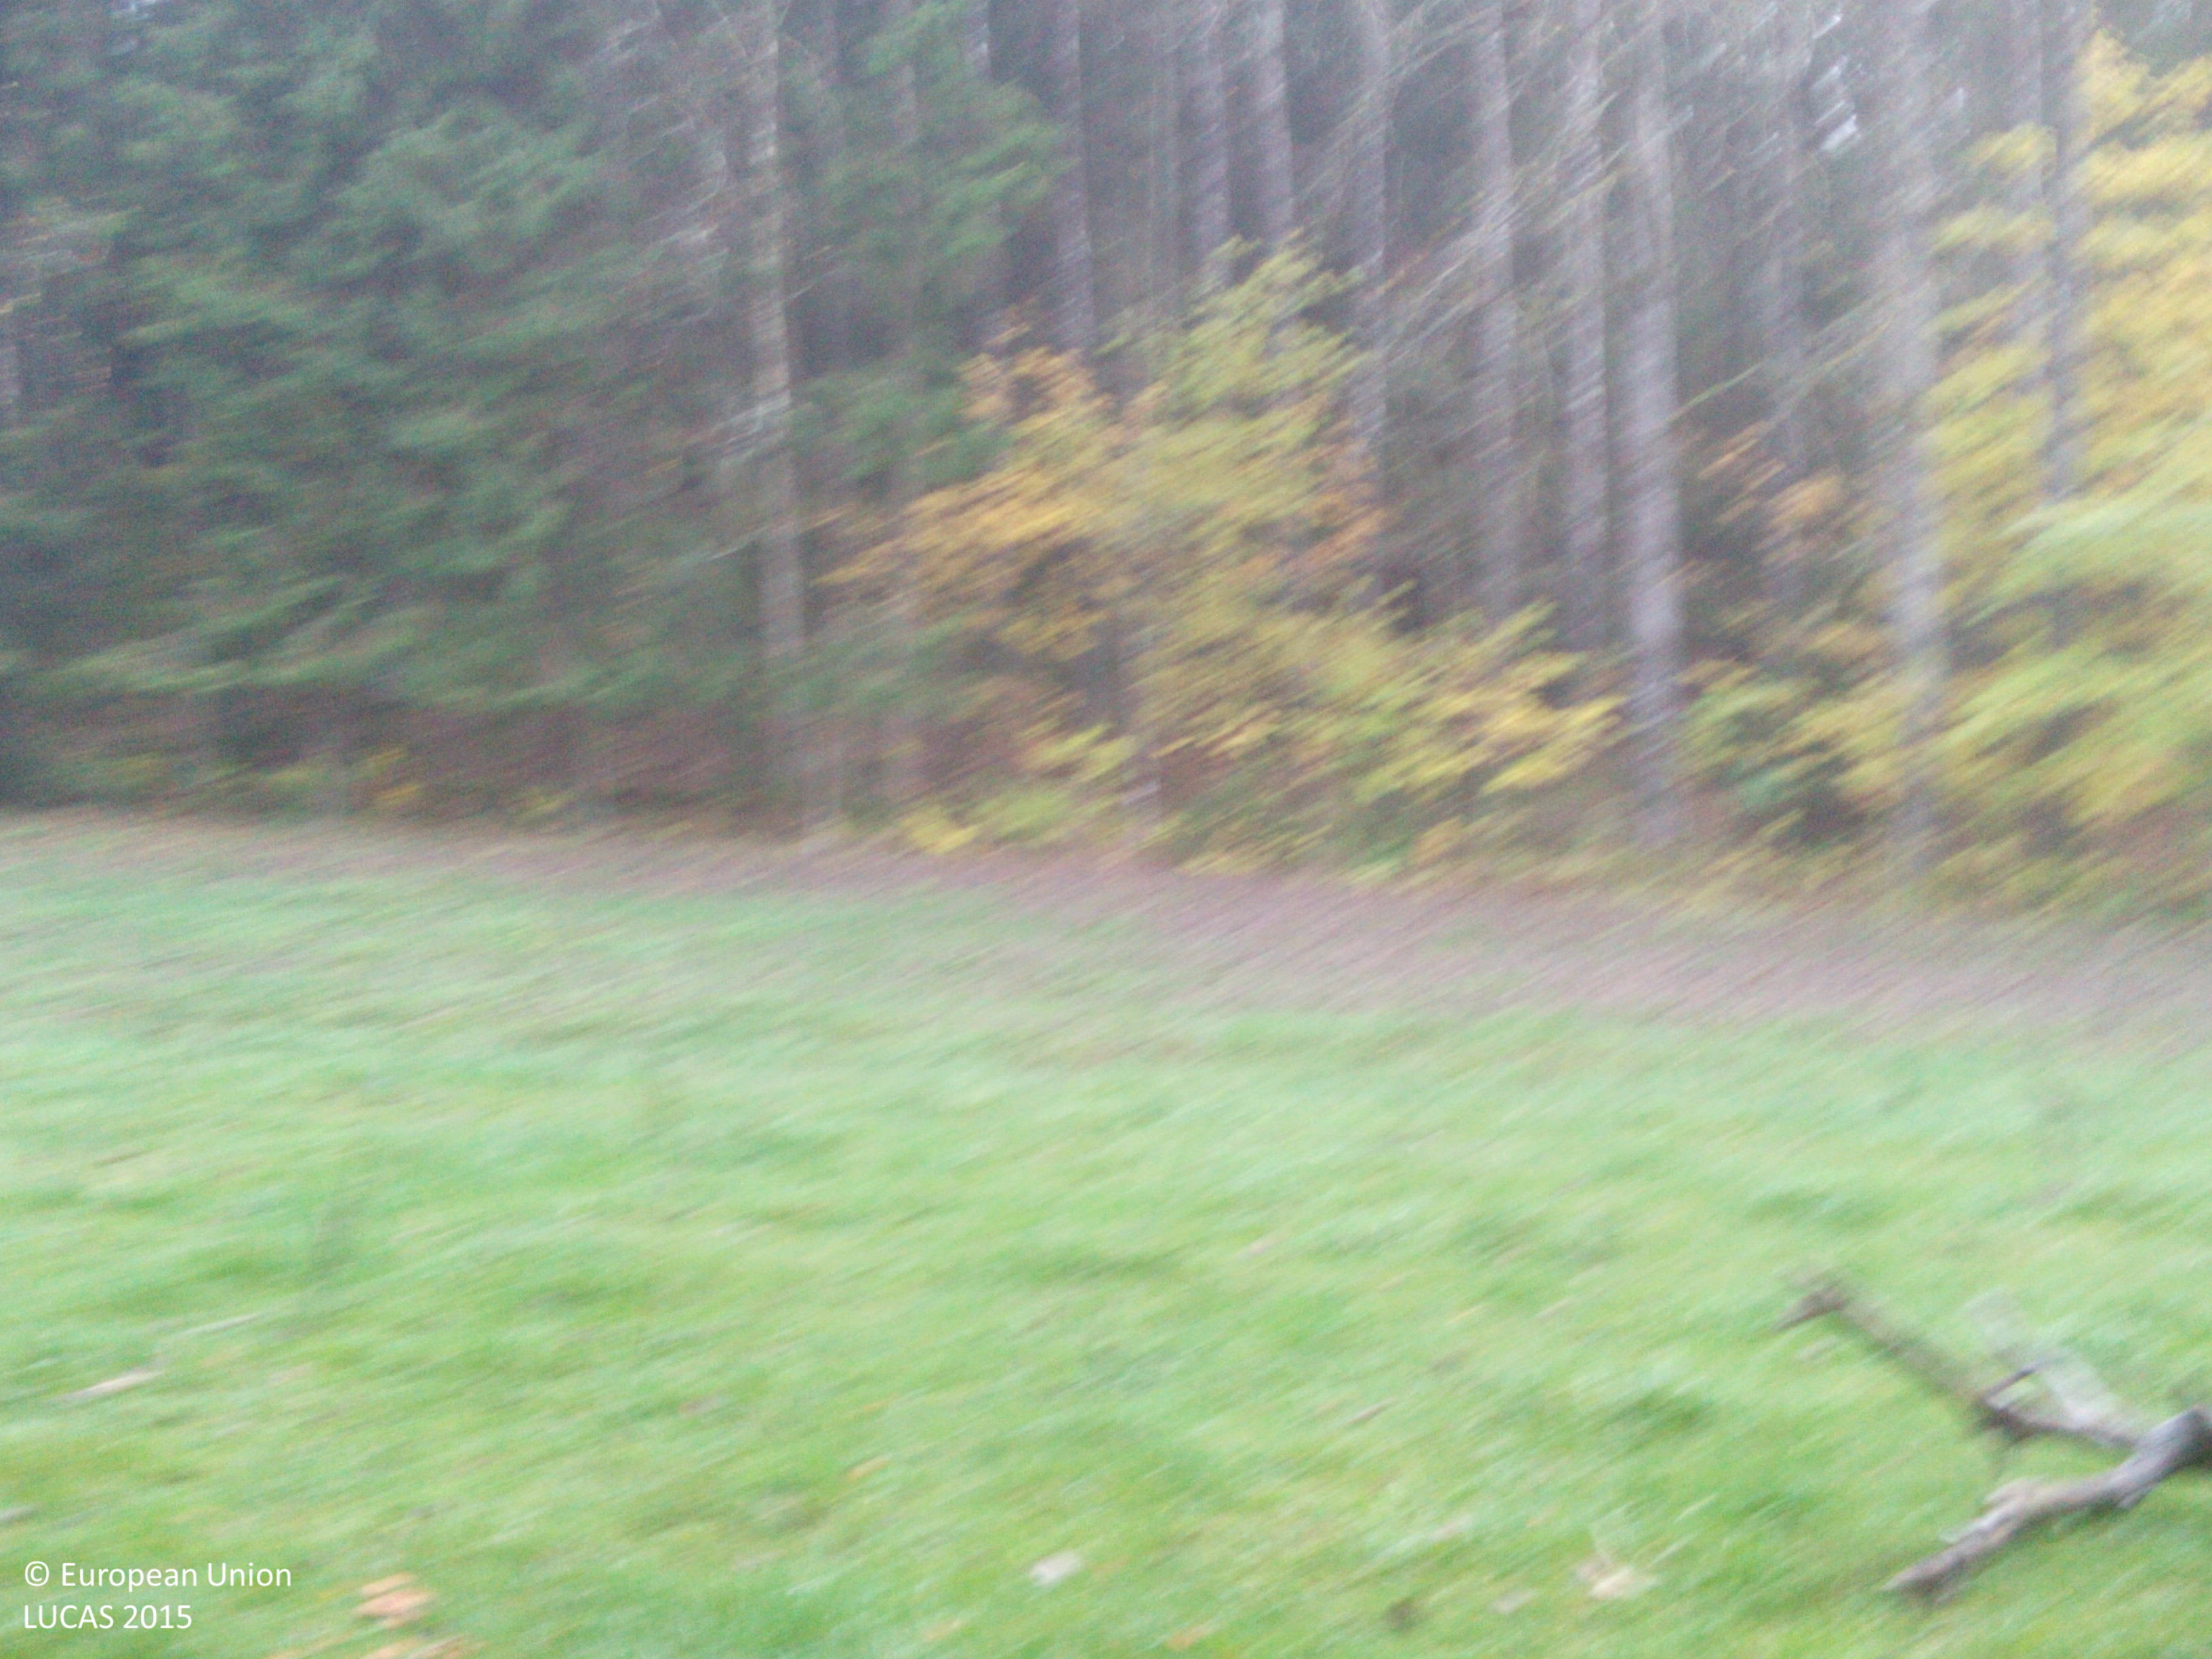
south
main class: Grassland
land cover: Grassland with sparse tree/shrub cover
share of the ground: > 75 %
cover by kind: herbaceous plants 95 %, broadleaved forest trees 5 %
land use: Agriculture (excluding fallow land and kitchen gardens)
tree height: > 5 m
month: October
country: SE
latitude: 59.0066
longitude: 16.3838
